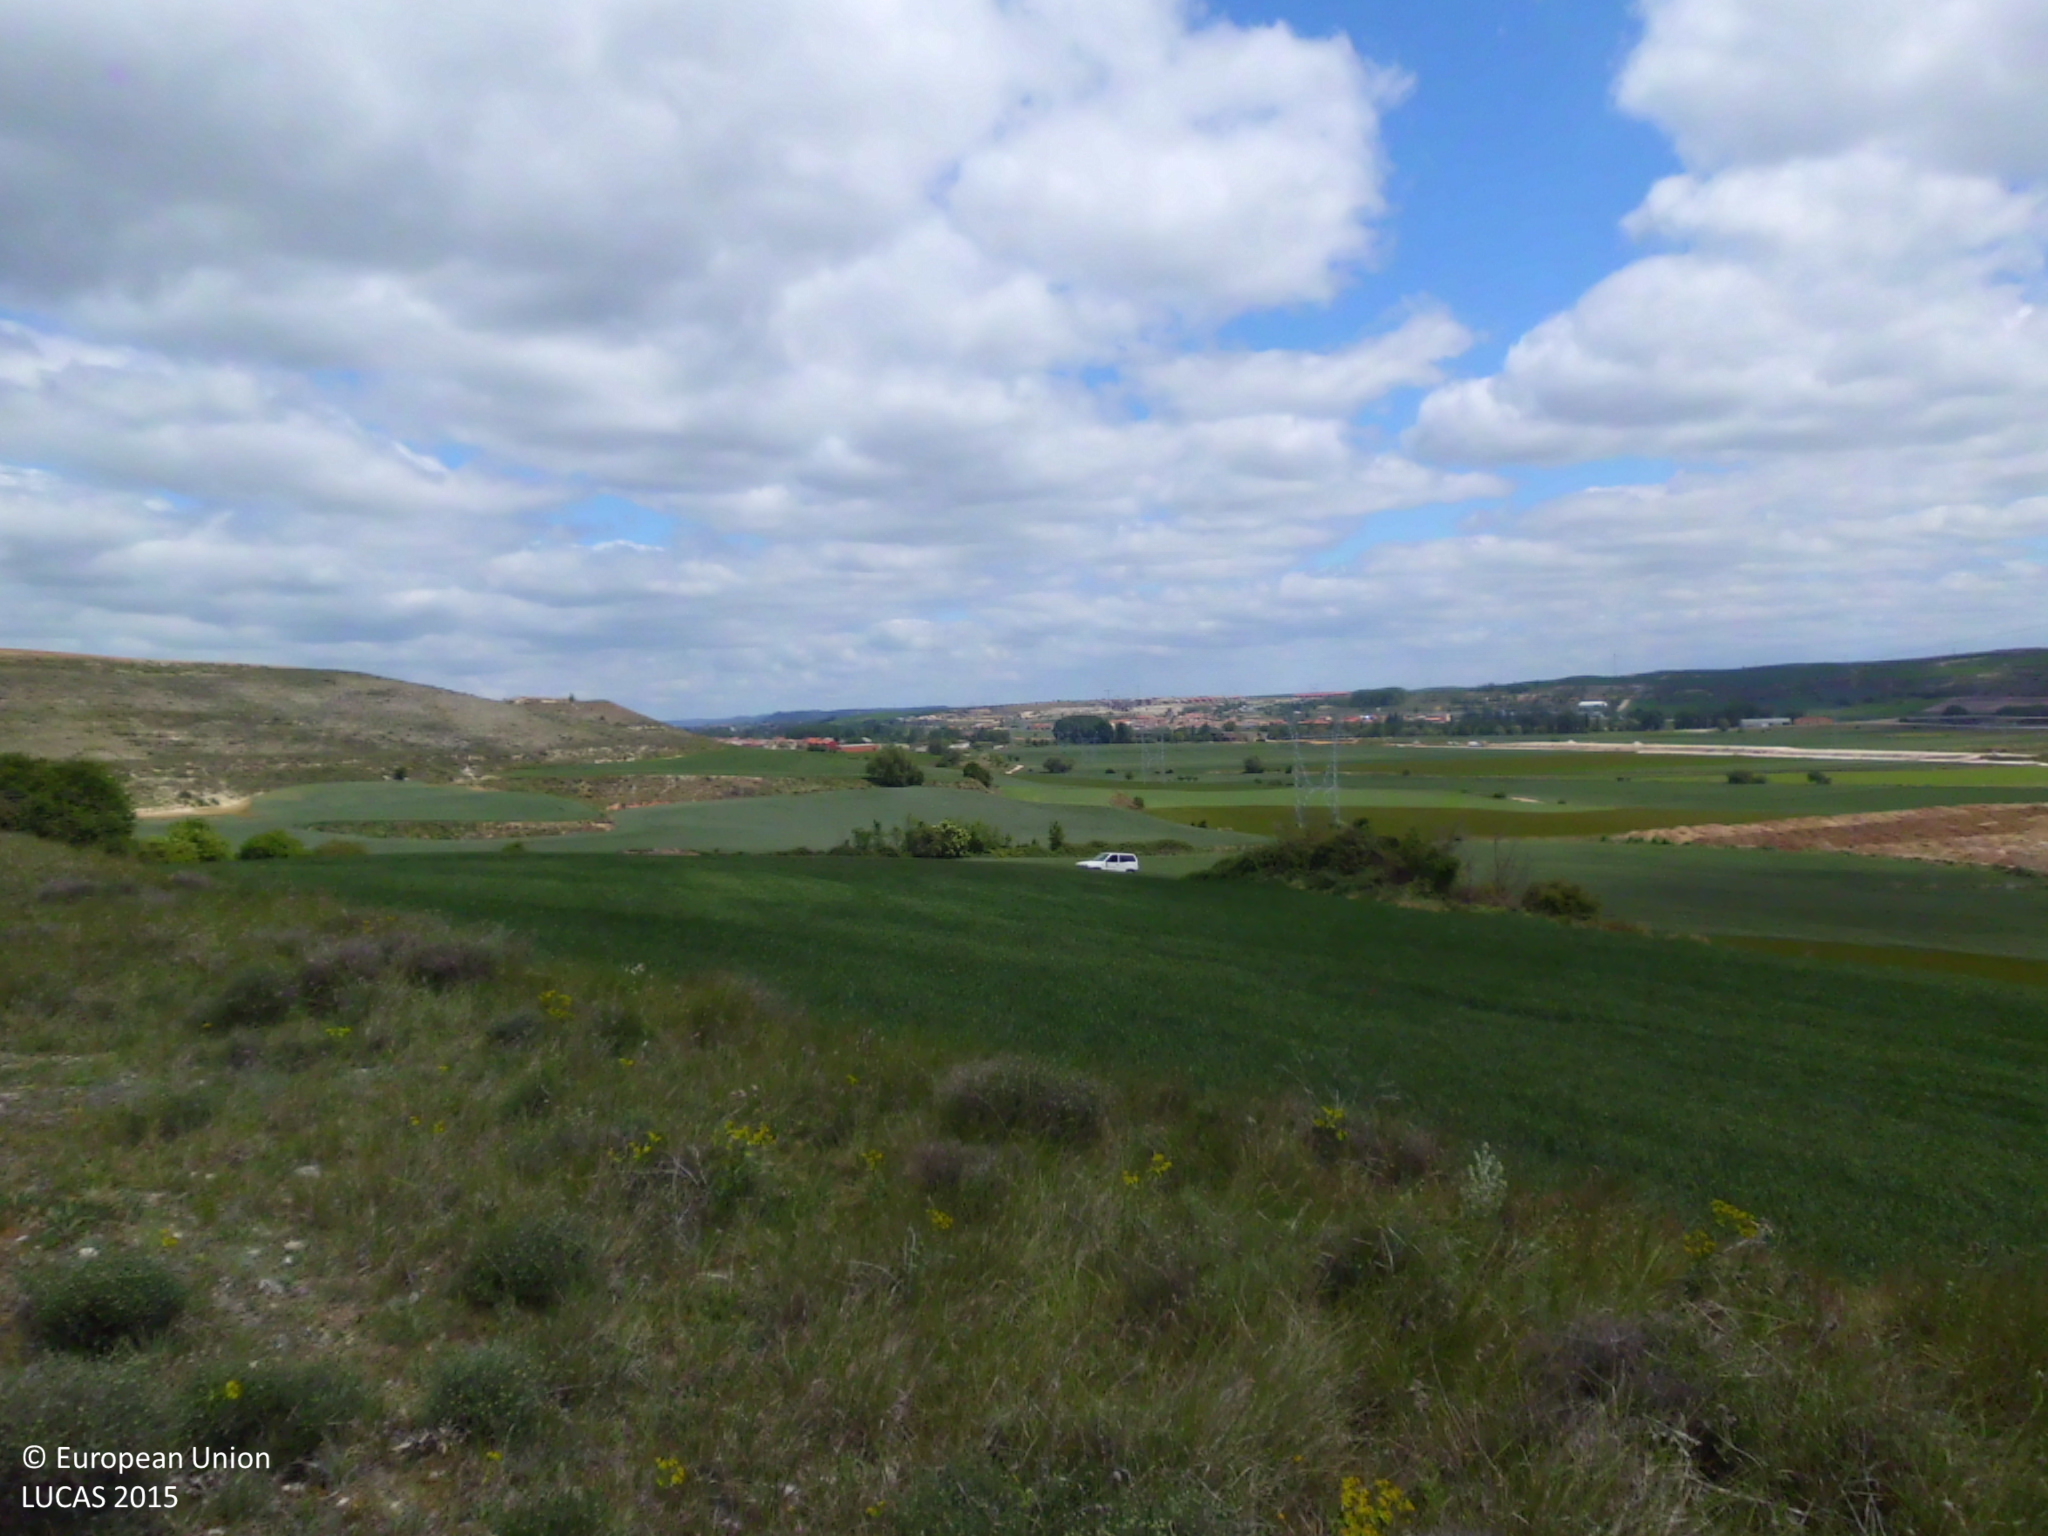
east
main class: Grassland
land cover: Grassland without tree/shrub cover
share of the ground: > 75 %
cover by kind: herbaceous plants 95 %, shrubs 5 %
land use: Semi-natural and natural areas not in use
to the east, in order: Grassland without tree/shrub cover; Common wheat; Grassland without tree/shrub cover; Common wheat; Electric lines; Tracks; Common wheat
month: May
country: ES
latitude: 42.3005
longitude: -3.8543
